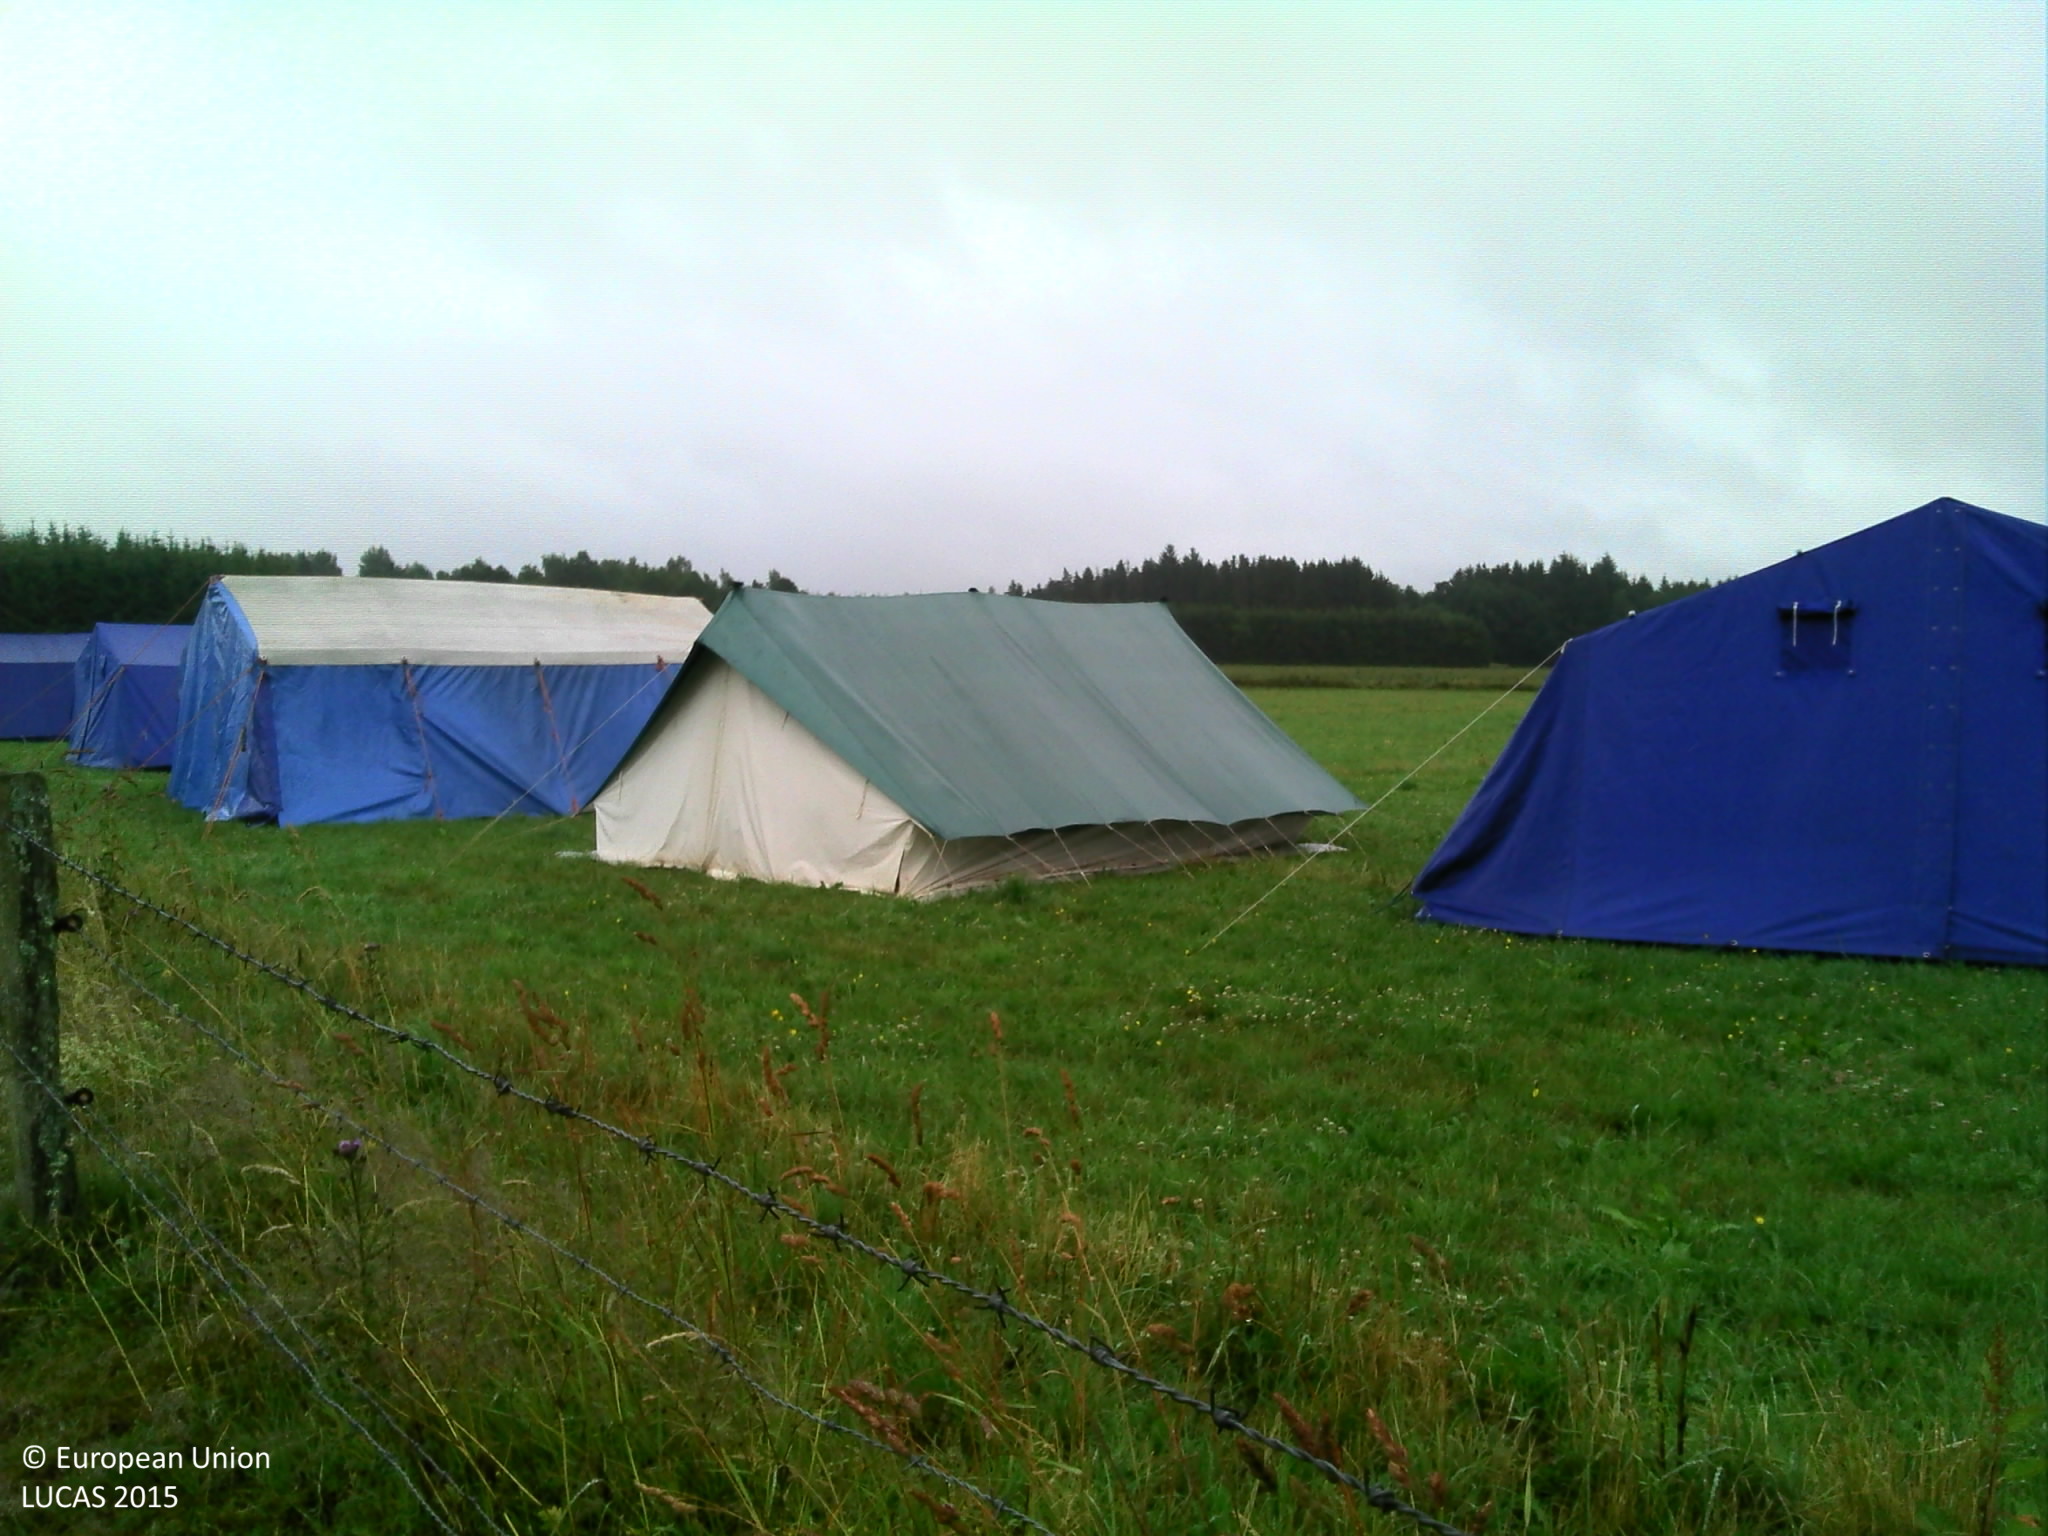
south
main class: Grassland
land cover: Grassland without tree/shrub cover
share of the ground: > 75 %
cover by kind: herbaceous plants 100 %
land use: Agriculture (excluding fallow land and kitchen gardens)
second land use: Amenities, museums, leisure
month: July
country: BE
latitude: 50.1583
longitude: 5.7295
